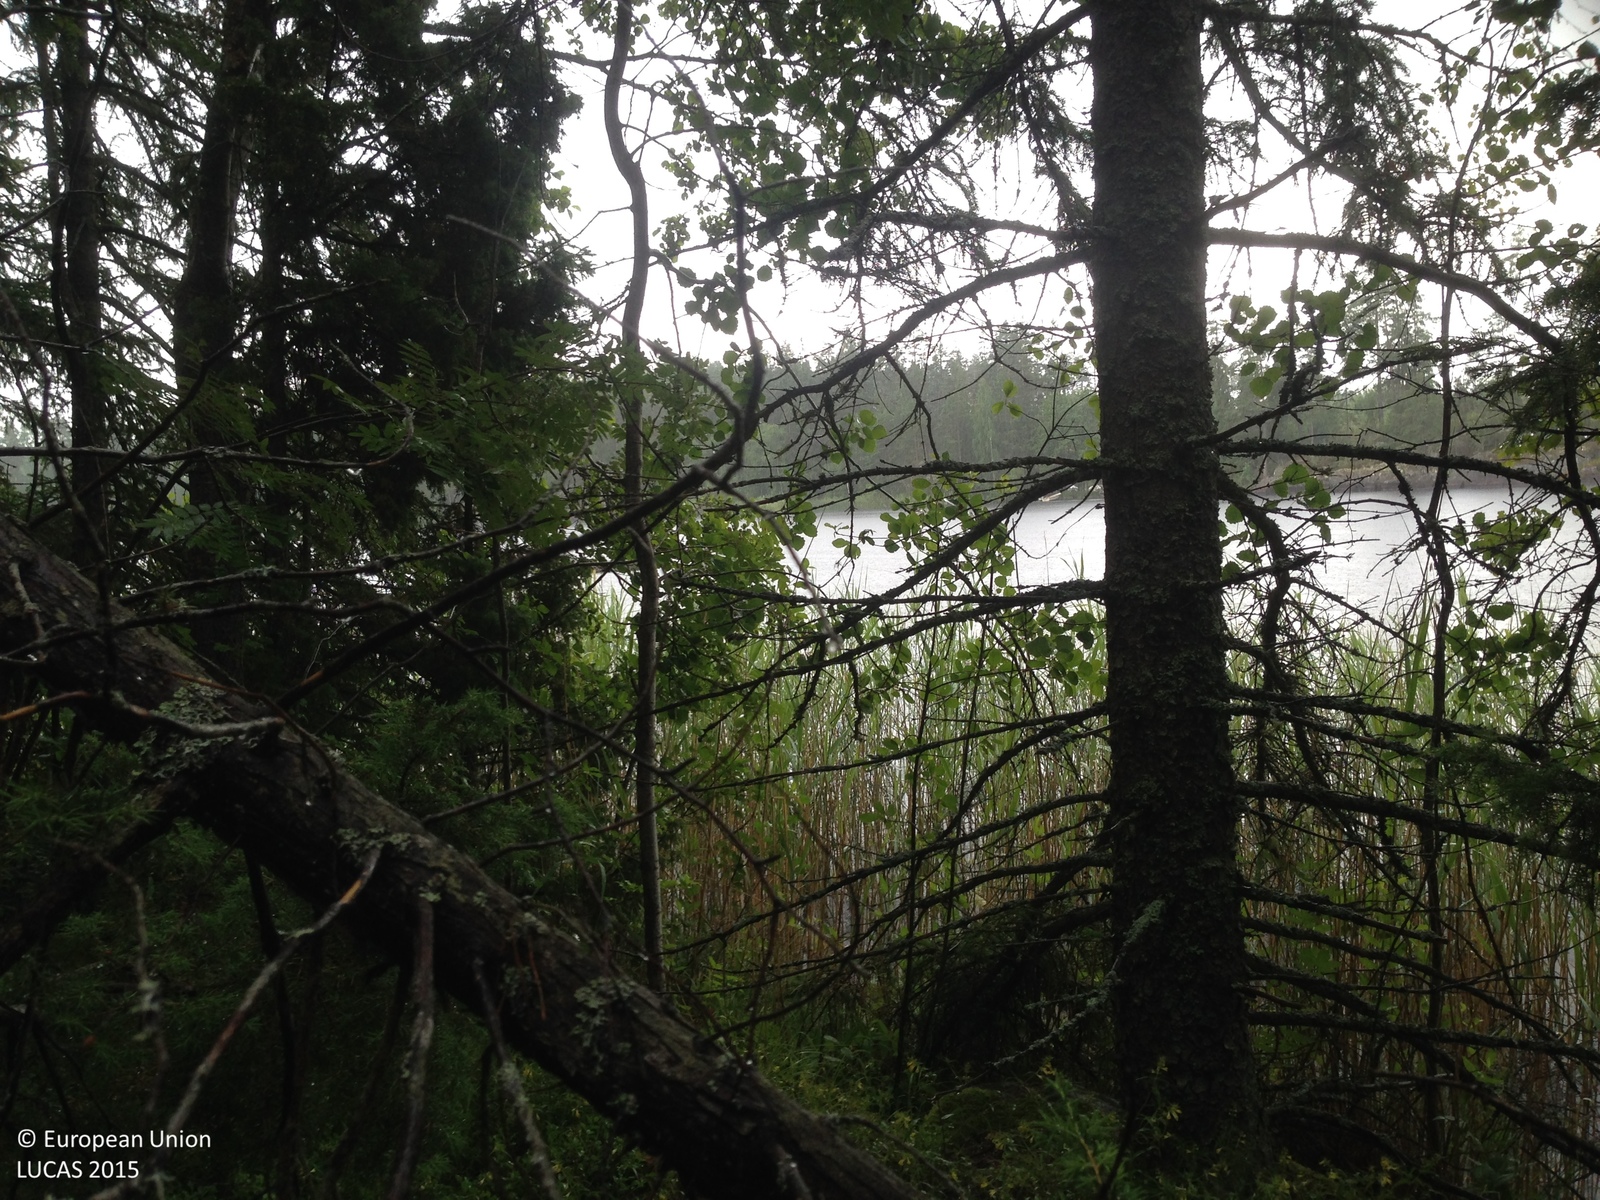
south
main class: Woodland
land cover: Spruce dominated coniferous woodland
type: boreal forest
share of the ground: > 75 %
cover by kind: coniferous forest trees 70 %, shrubs 15 %, lichens and mosses 10 %, broadleaved forest trees 5 %
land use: Forestry
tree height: > 5 m
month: July
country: SE
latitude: 59.9577
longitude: 18.5399
